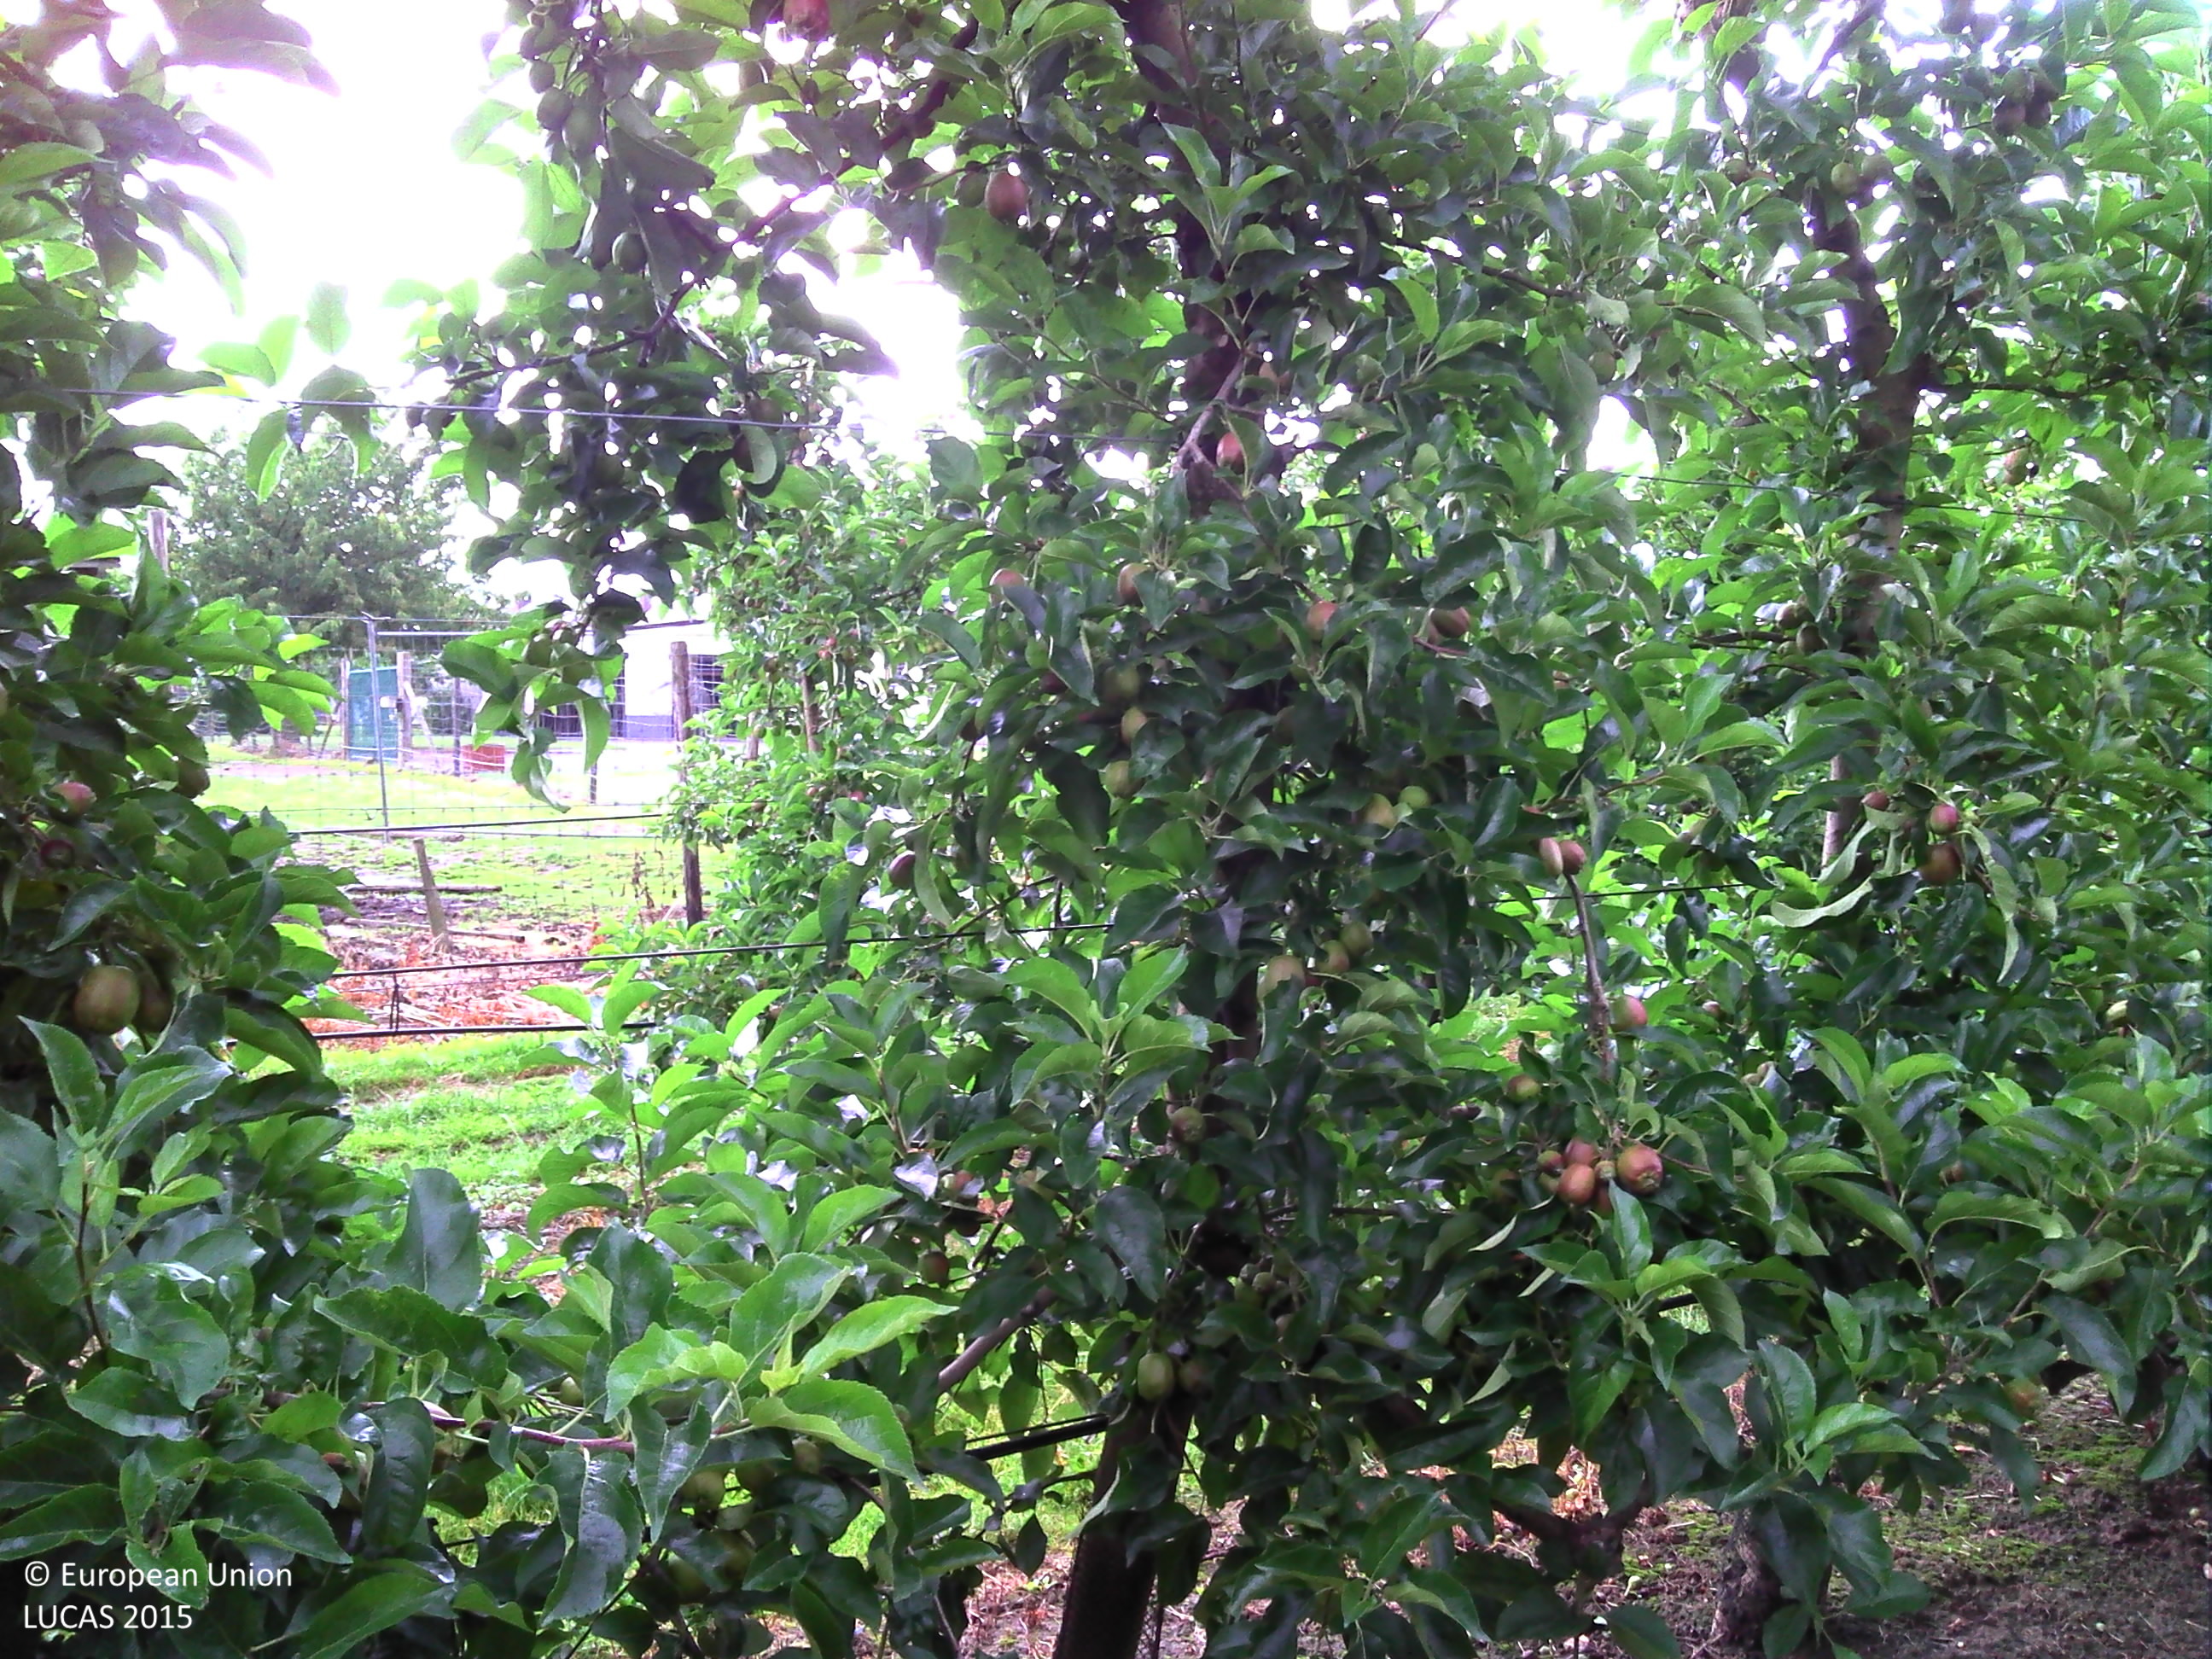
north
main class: Cropland
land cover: Apple fruit
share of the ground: 50 - 75 %
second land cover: Grassland without tree/shrub cover
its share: 25 - 50 %
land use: Agriculture (excluding fallow land and kitchen gardens)
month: June
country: BE
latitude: 50.8964
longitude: 5.2631
